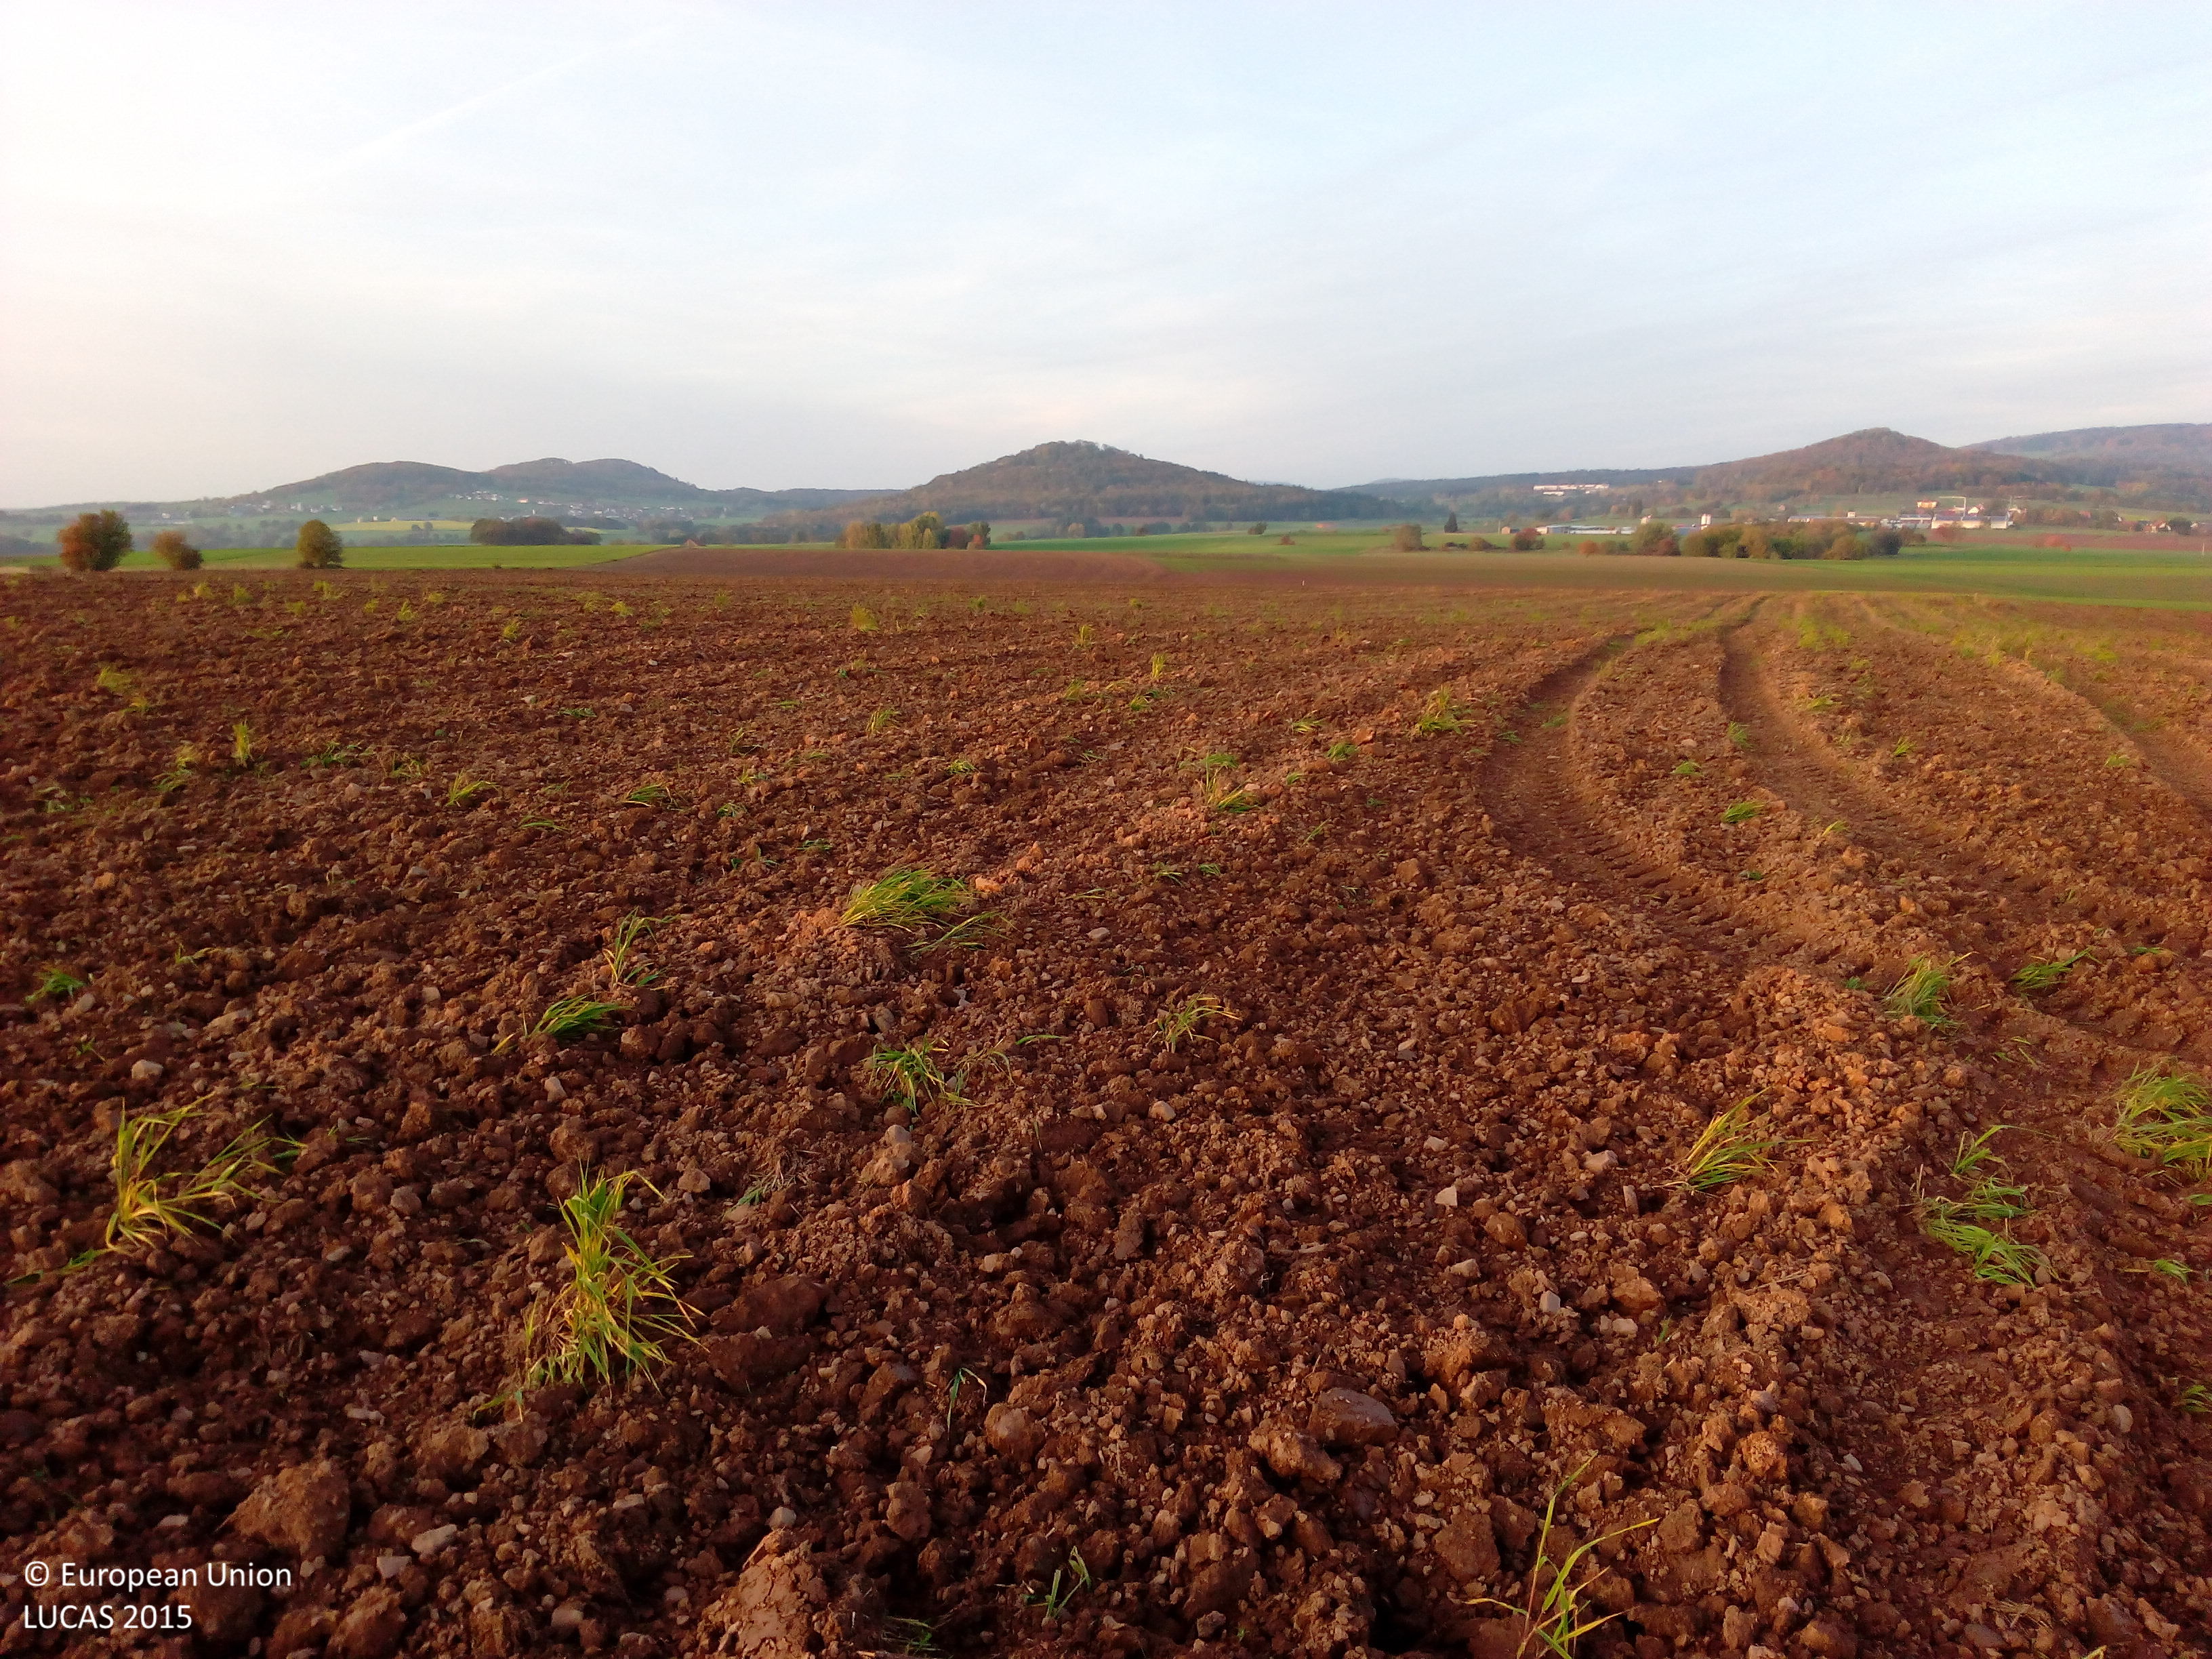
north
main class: Cropland
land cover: Barley
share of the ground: < 10 %
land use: Agriculture (excluding fallow land and kitchen gardens)
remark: Tilled/Sowed
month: October
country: DE
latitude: 50.2561
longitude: 9.8458
